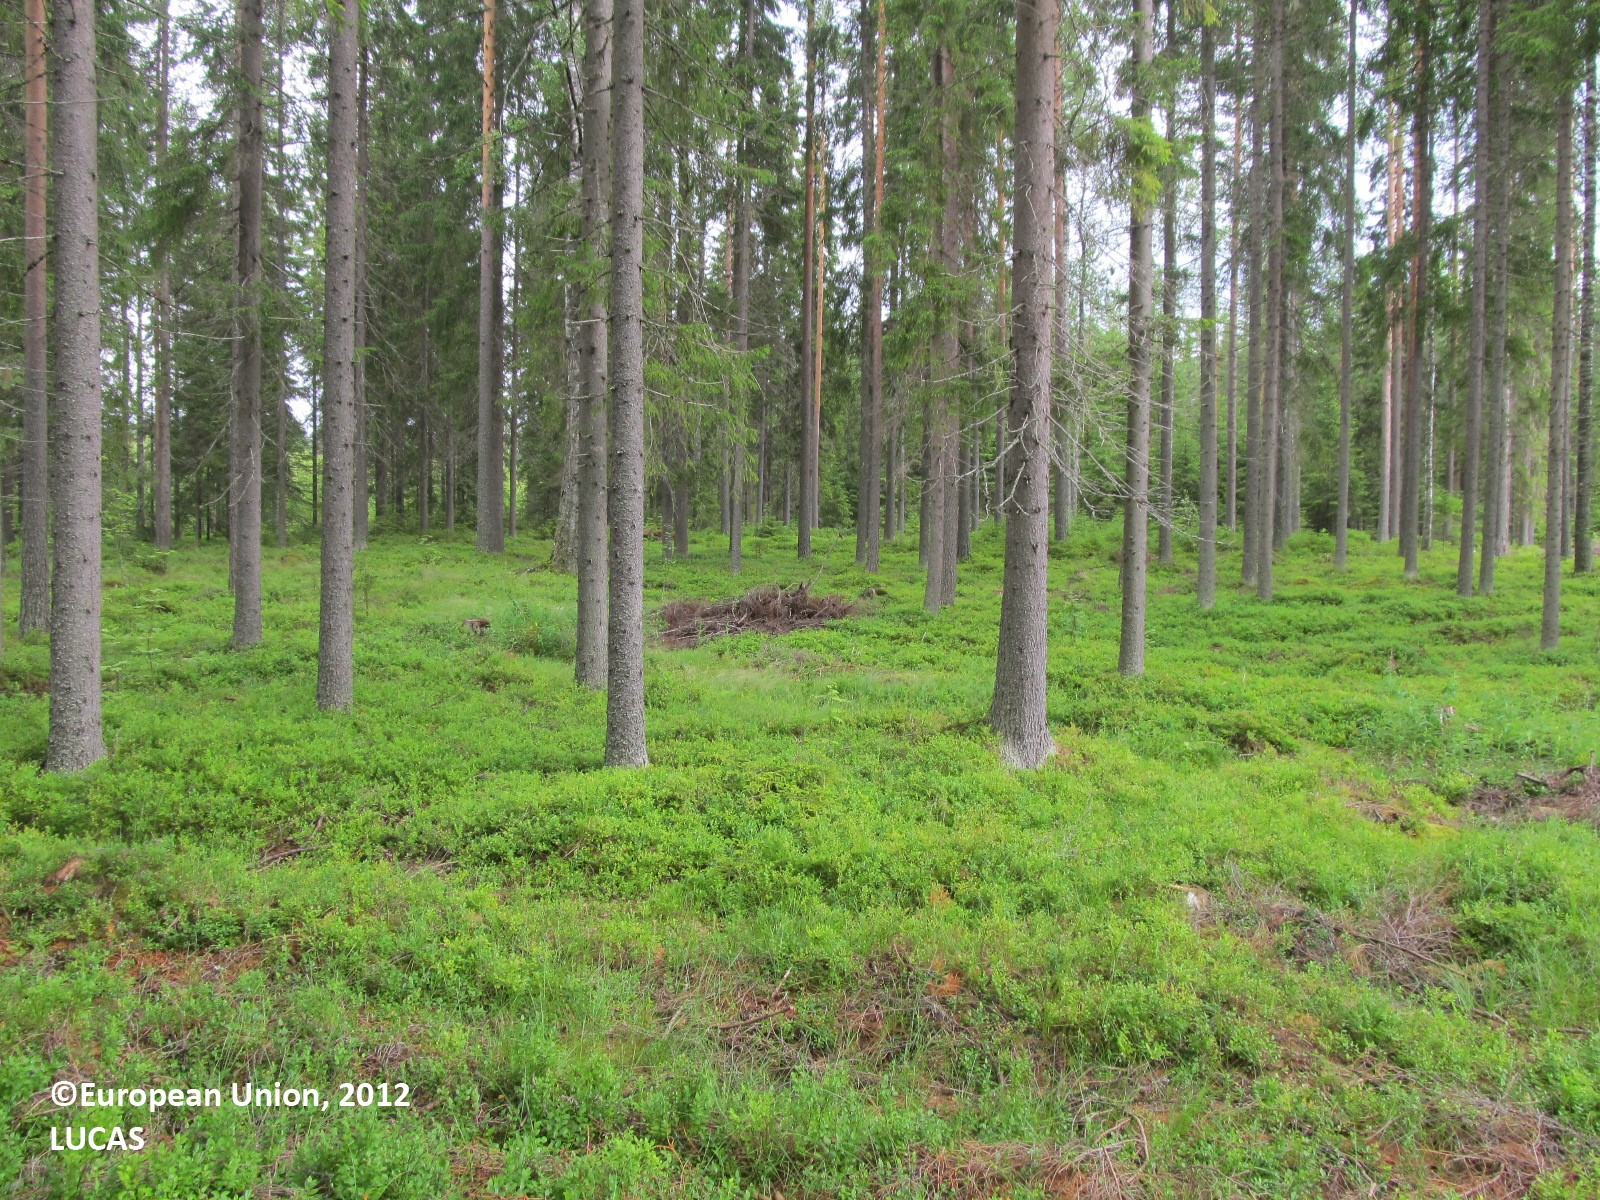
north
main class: Woodland
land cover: Spruce dominated coniferous woodland
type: boreal forest
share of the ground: 25 - 50 %
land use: Forestry
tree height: > 5 m
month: July
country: FI
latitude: 61.8884
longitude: 28.4109
